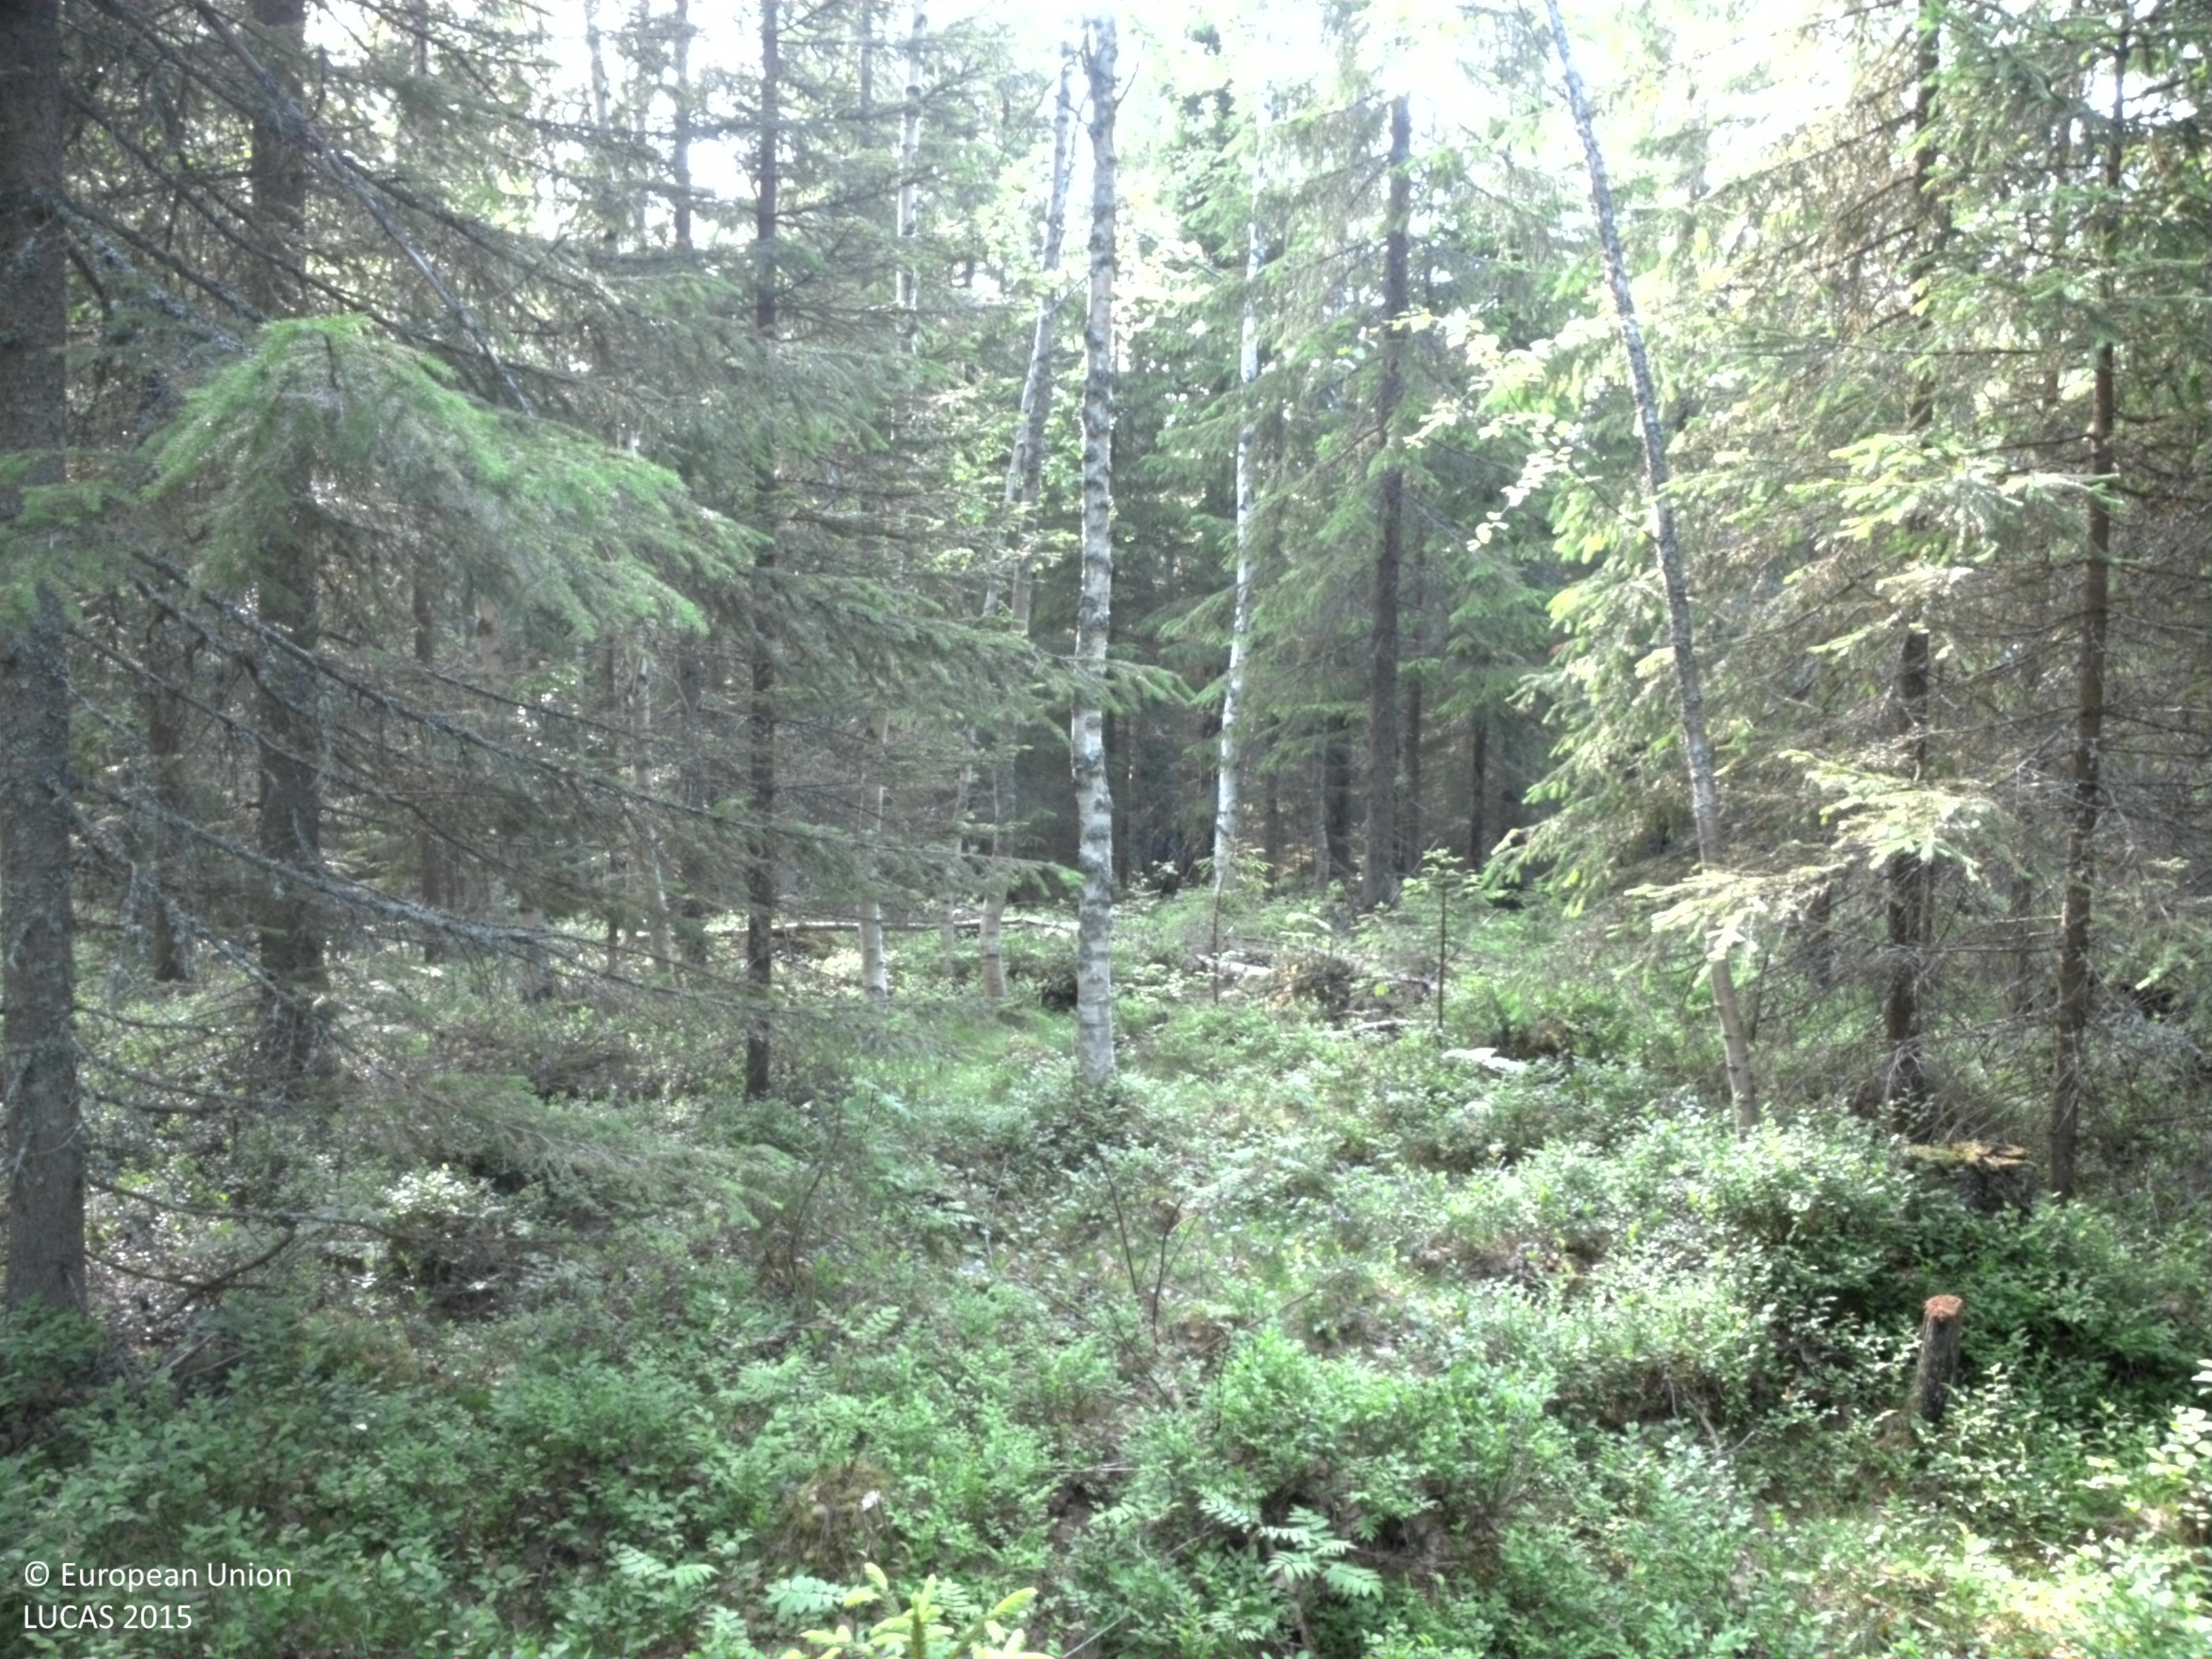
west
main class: Woodland
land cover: Other mixed woodland
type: boreal forest
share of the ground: 50 - 75 %
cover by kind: coniferous forest trees 45 %, shrubs 35 %, broadleaved forest trees 15 %, herbaceous plants 5 %
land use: Forestry
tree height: > 5 m
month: July
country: SE
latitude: 64.4456
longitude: 20.8467
